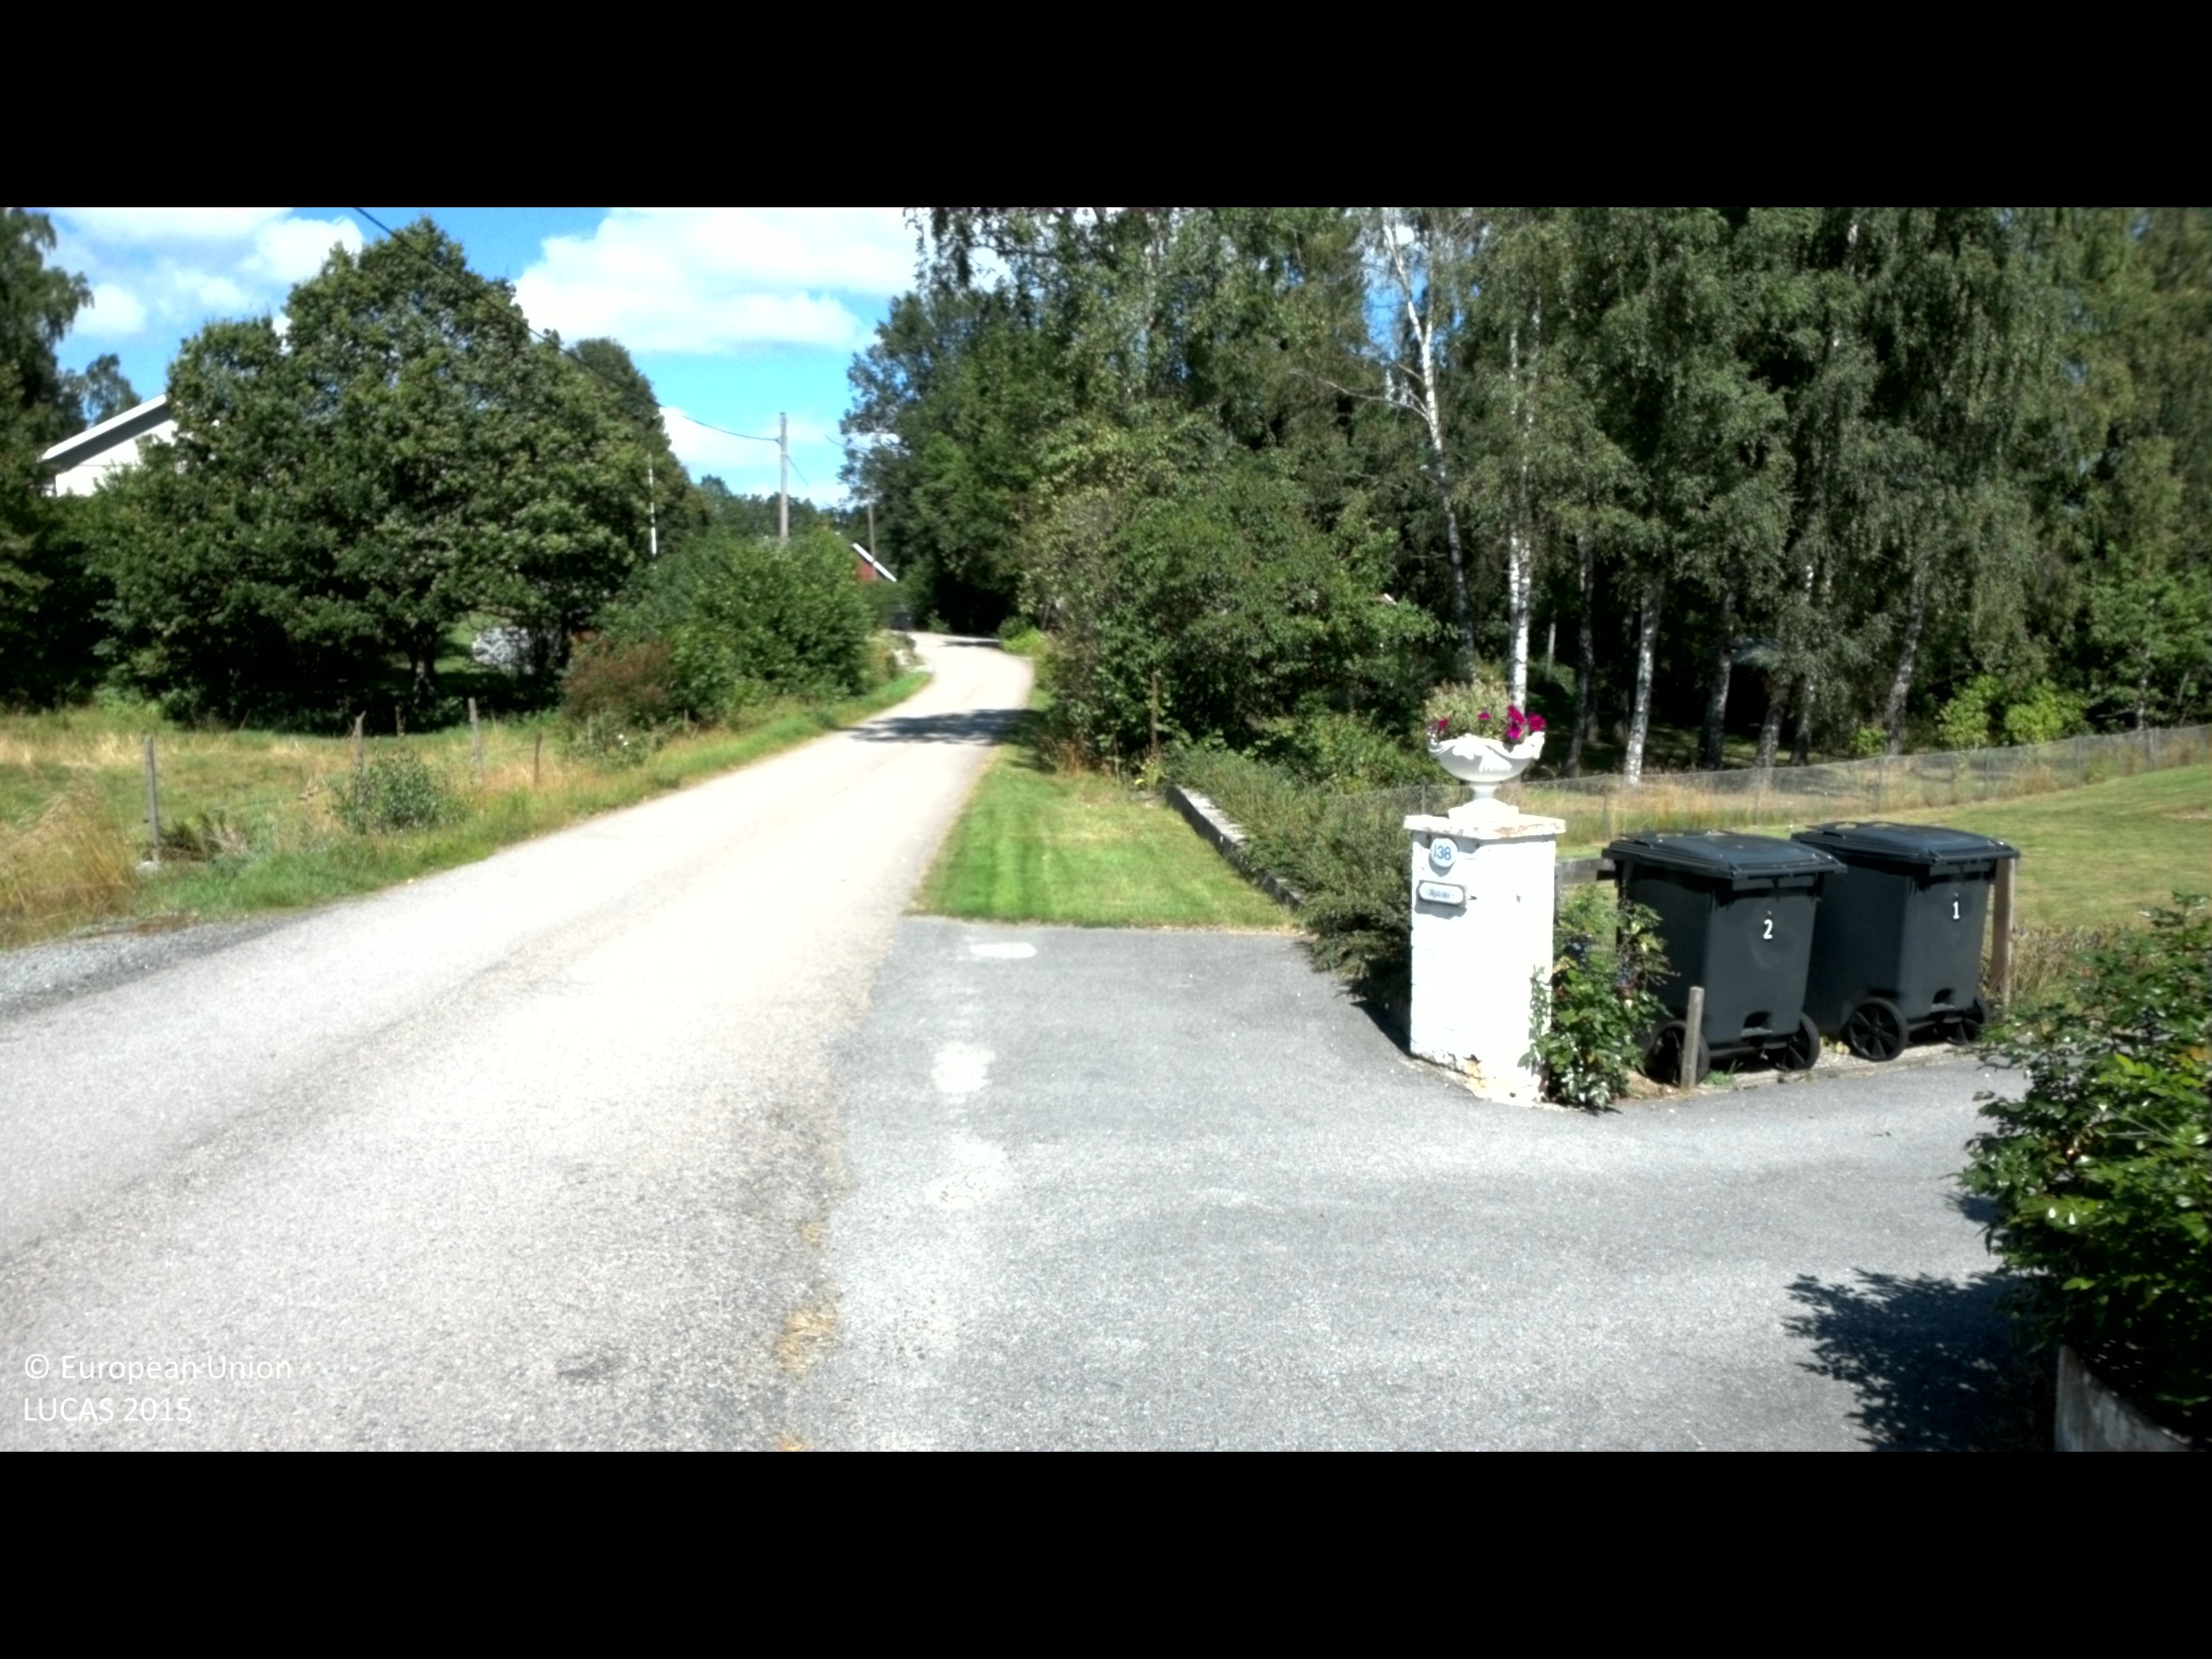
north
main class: Grassland
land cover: Grassland without tree/shrub cover
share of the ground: > 75 %
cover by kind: herbaceous plants 100 %
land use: Residential
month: August
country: SE
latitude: 56.2425
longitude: 14.7907
